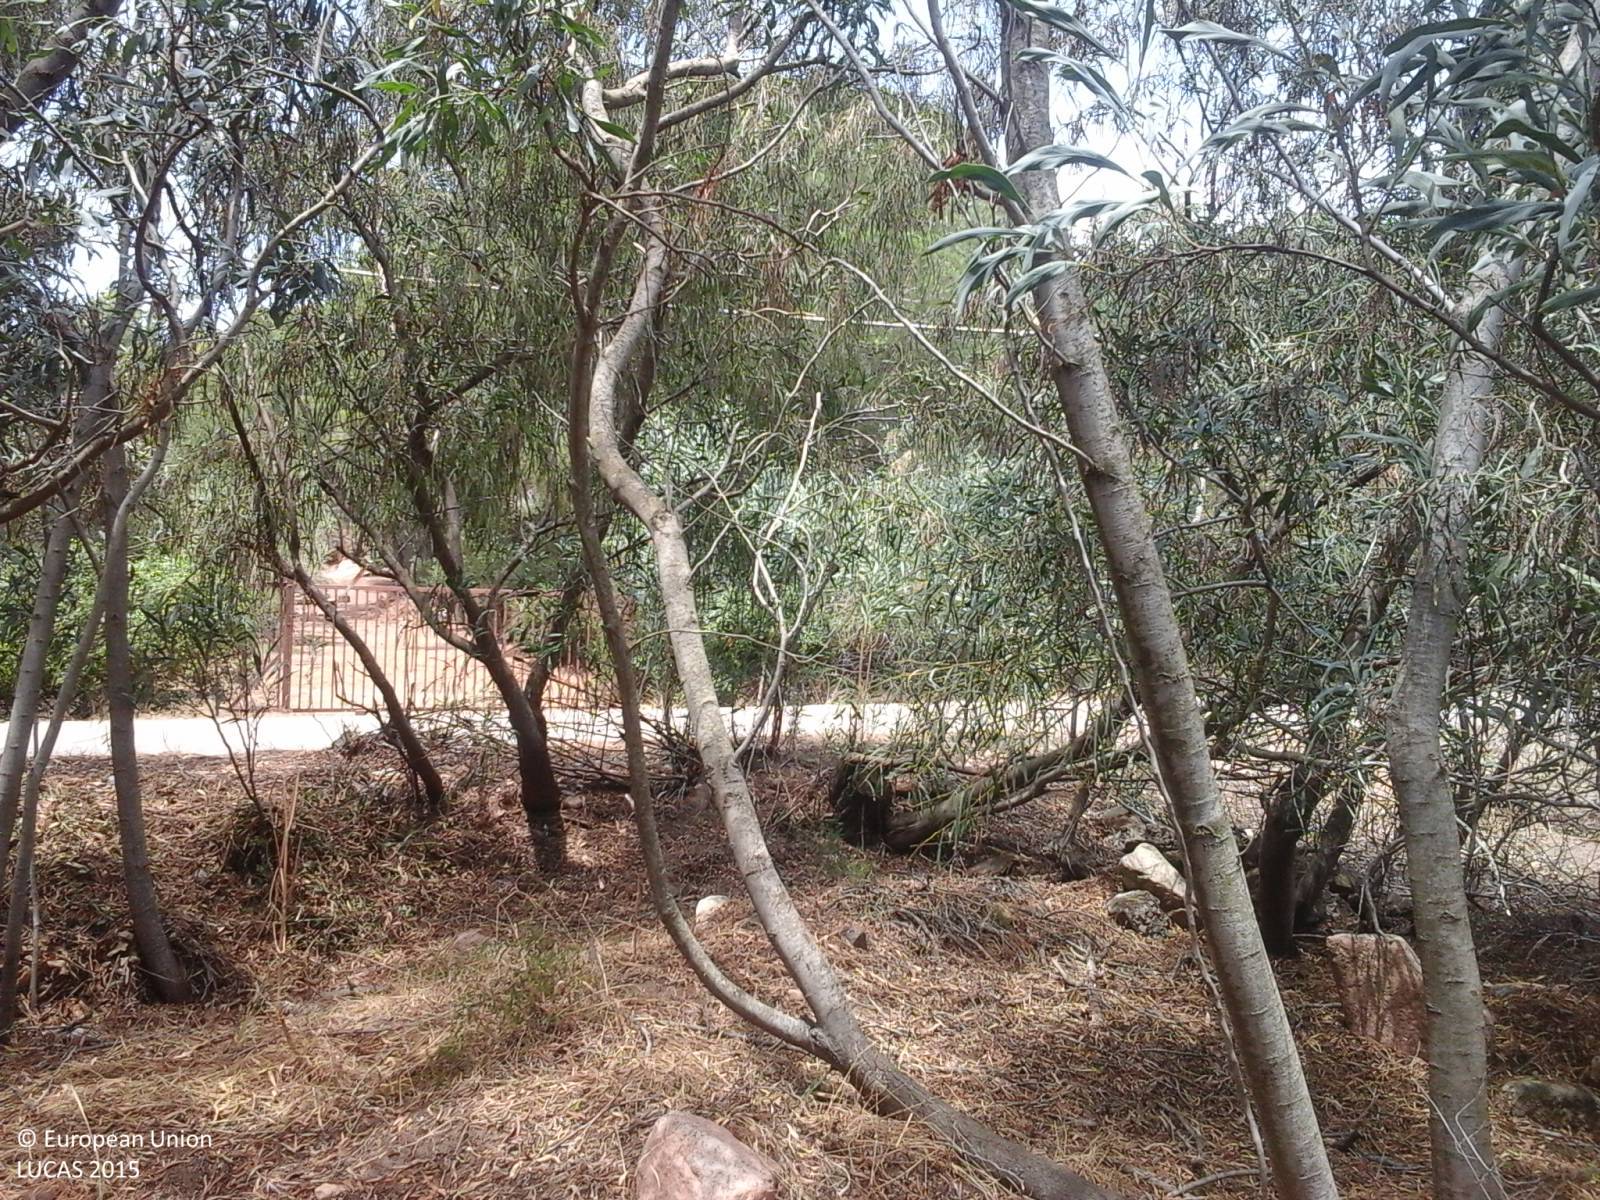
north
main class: Woodland
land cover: Broadleaved woodland
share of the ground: 50 - 75 %
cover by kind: broadleaved forest trees 65 %, unconsolidated bare surface 20 %, shrubs 10 %, herbaceous plants 5 %
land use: Abandoned areas
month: June
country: IT
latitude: 39.3609
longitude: 9.5963
